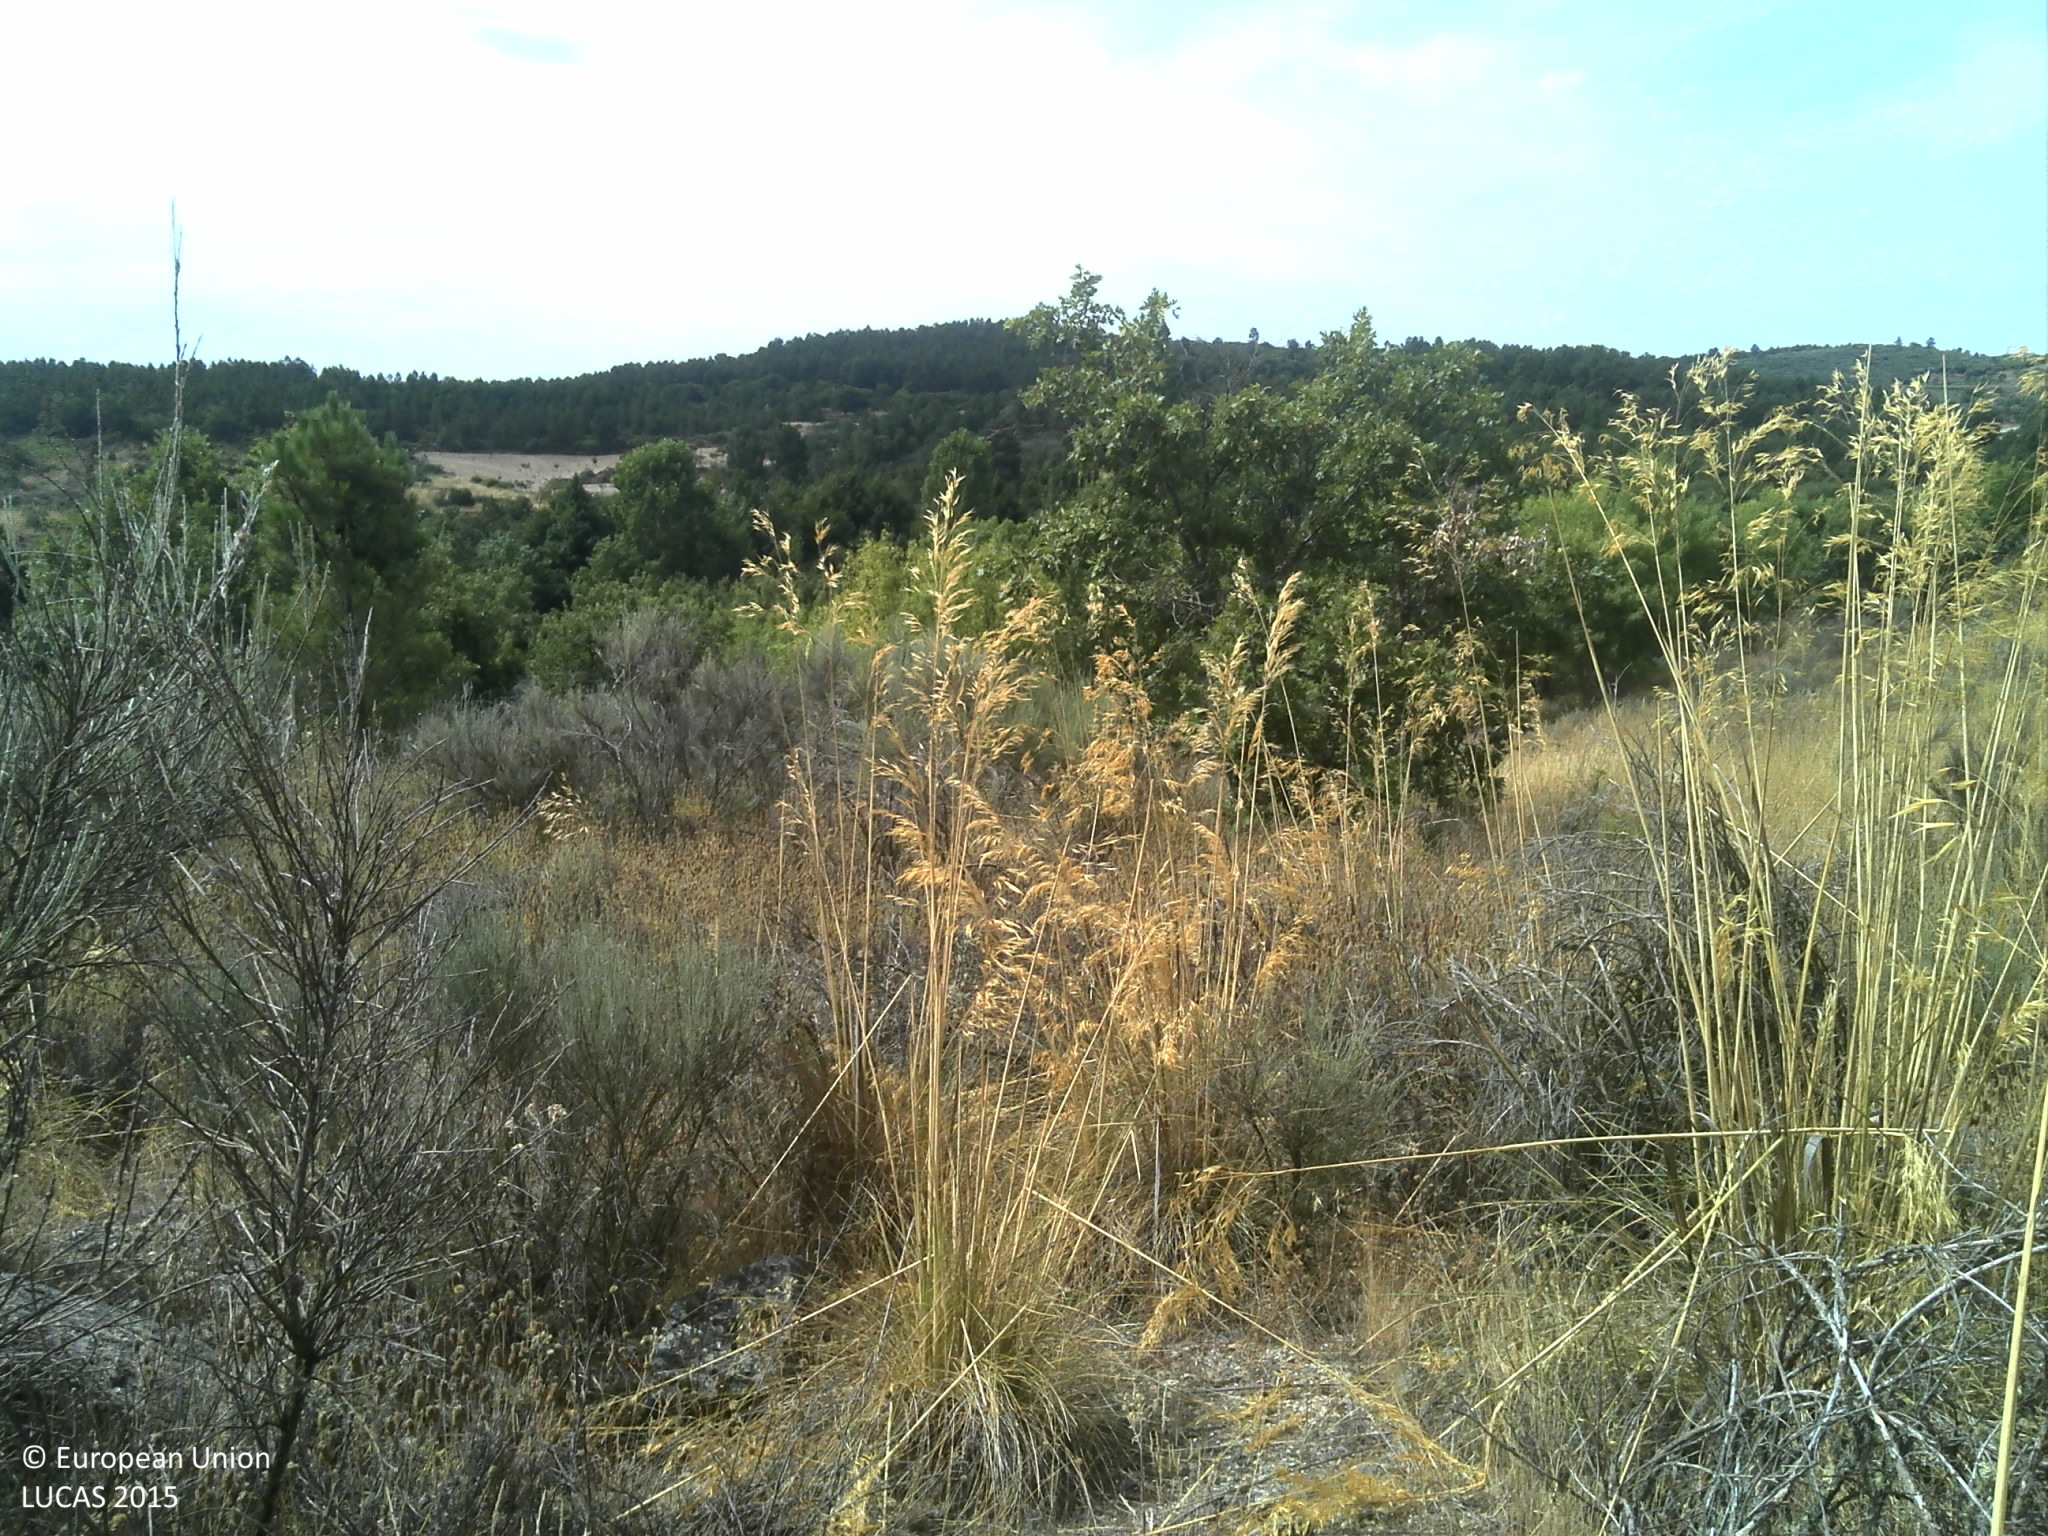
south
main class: Shrubland
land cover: Shrubland with sparse tree cover
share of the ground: > 75 %
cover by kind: shrubs 75 %, unconsolidated bare surface 10 %, broadleaved forest trees 5 %, herbaceous plants 5 %, consolidated bare surface 5 %
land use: Semi-natural and natural areas not in use
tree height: > 5 m
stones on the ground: > 50 %
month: July
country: PT
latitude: 40.9012
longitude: -7.3624
